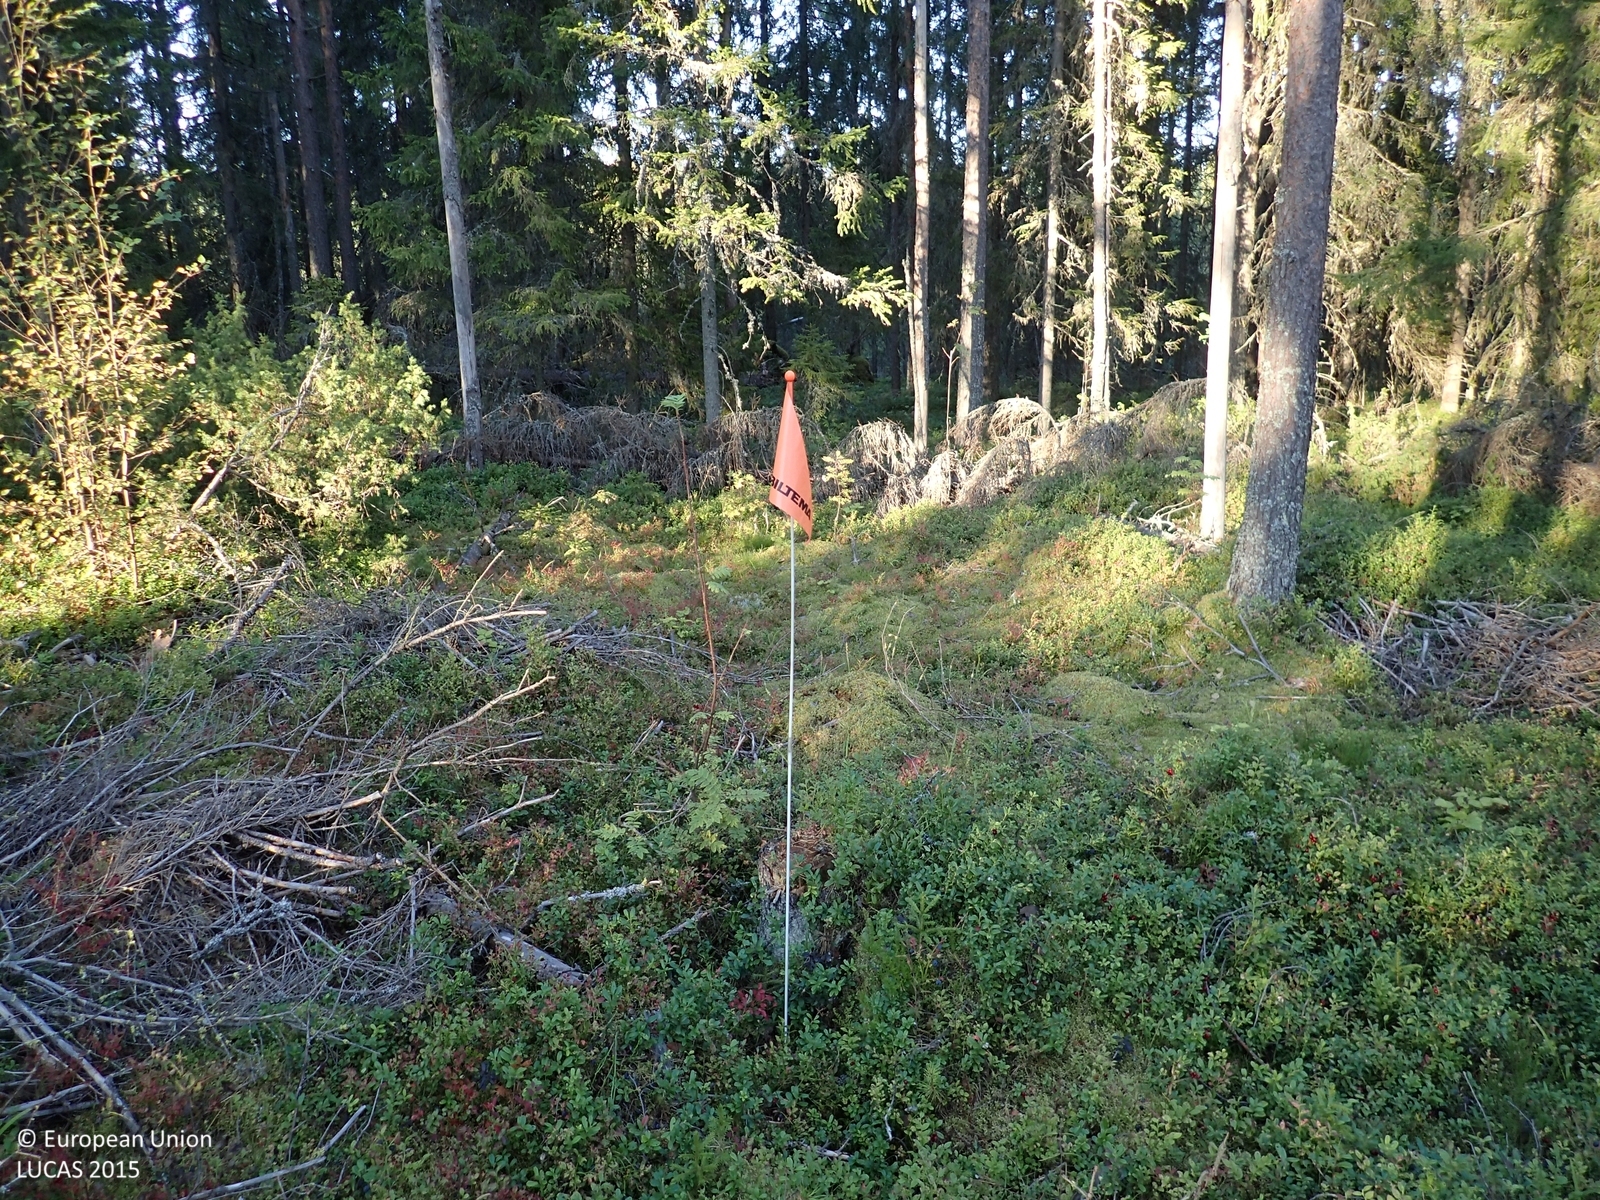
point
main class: Woodland
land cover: Other coniferous woodland
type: boreal forest
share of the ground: > 75 %
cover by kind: coniferous forest trees 75 %, shrubs 20 %, lichens and mosses 5 %
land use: Forestry
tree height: > 5 m
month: September
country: FI
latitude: 62.9091
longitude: 25.6808
